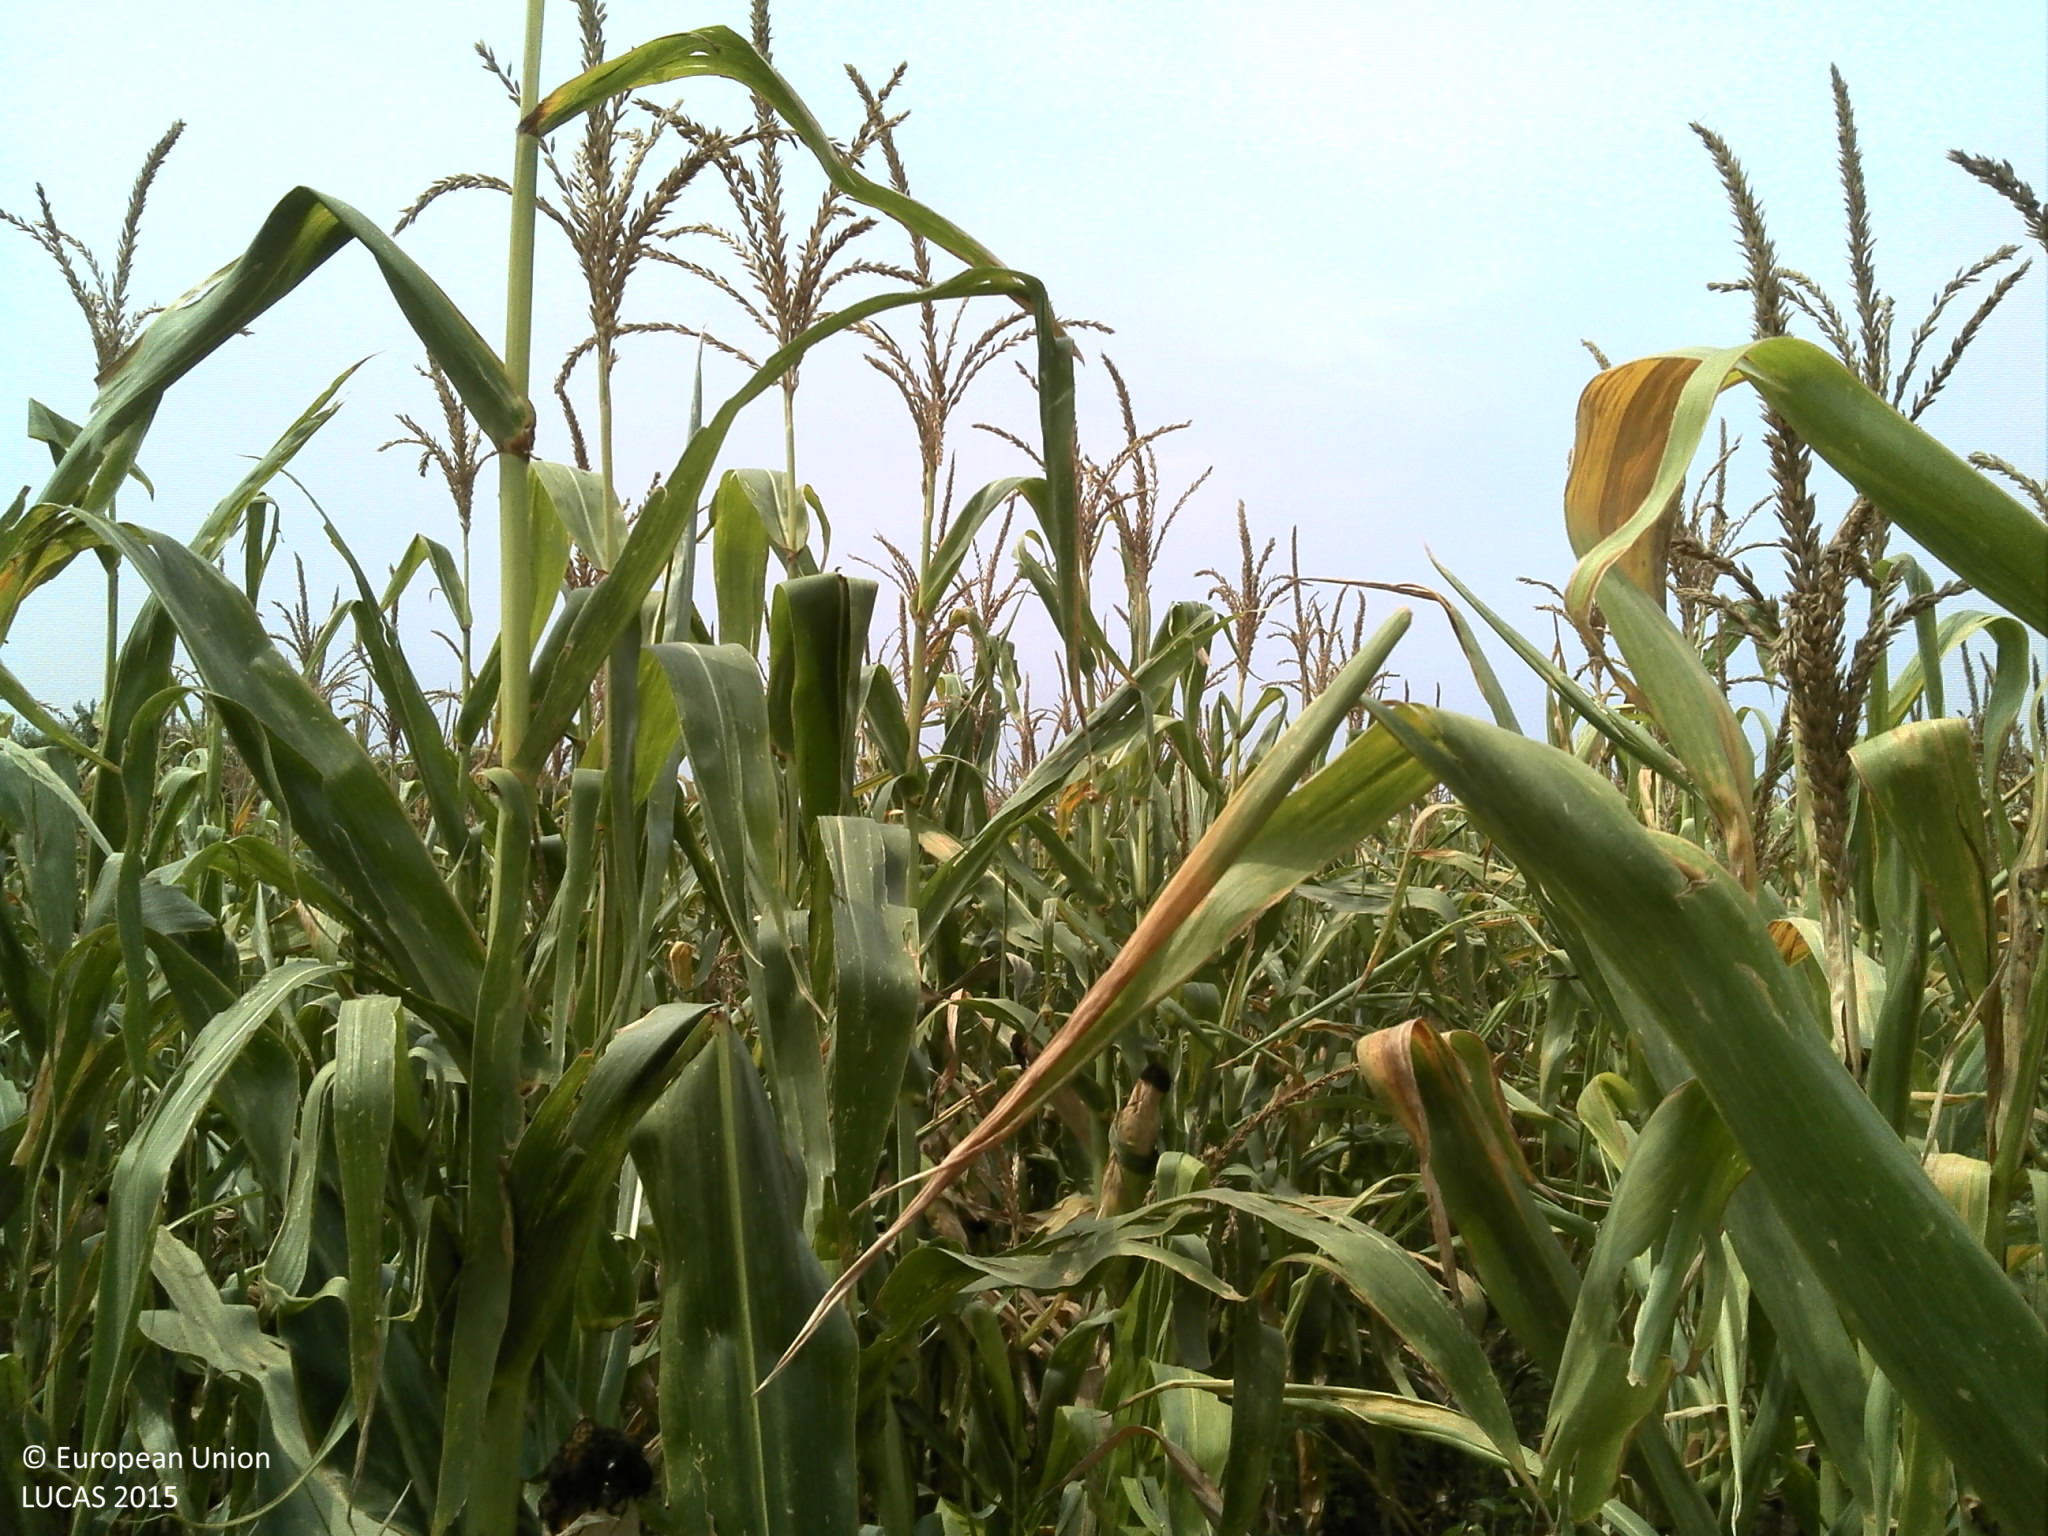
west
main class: Cropland
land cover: Maize
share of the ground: > 75 %
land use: Agriculture (excluding fallow land and kitchen gardens)
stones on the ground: < 10 %
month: August
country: HR
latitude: 45.4145
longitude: 18.5036
